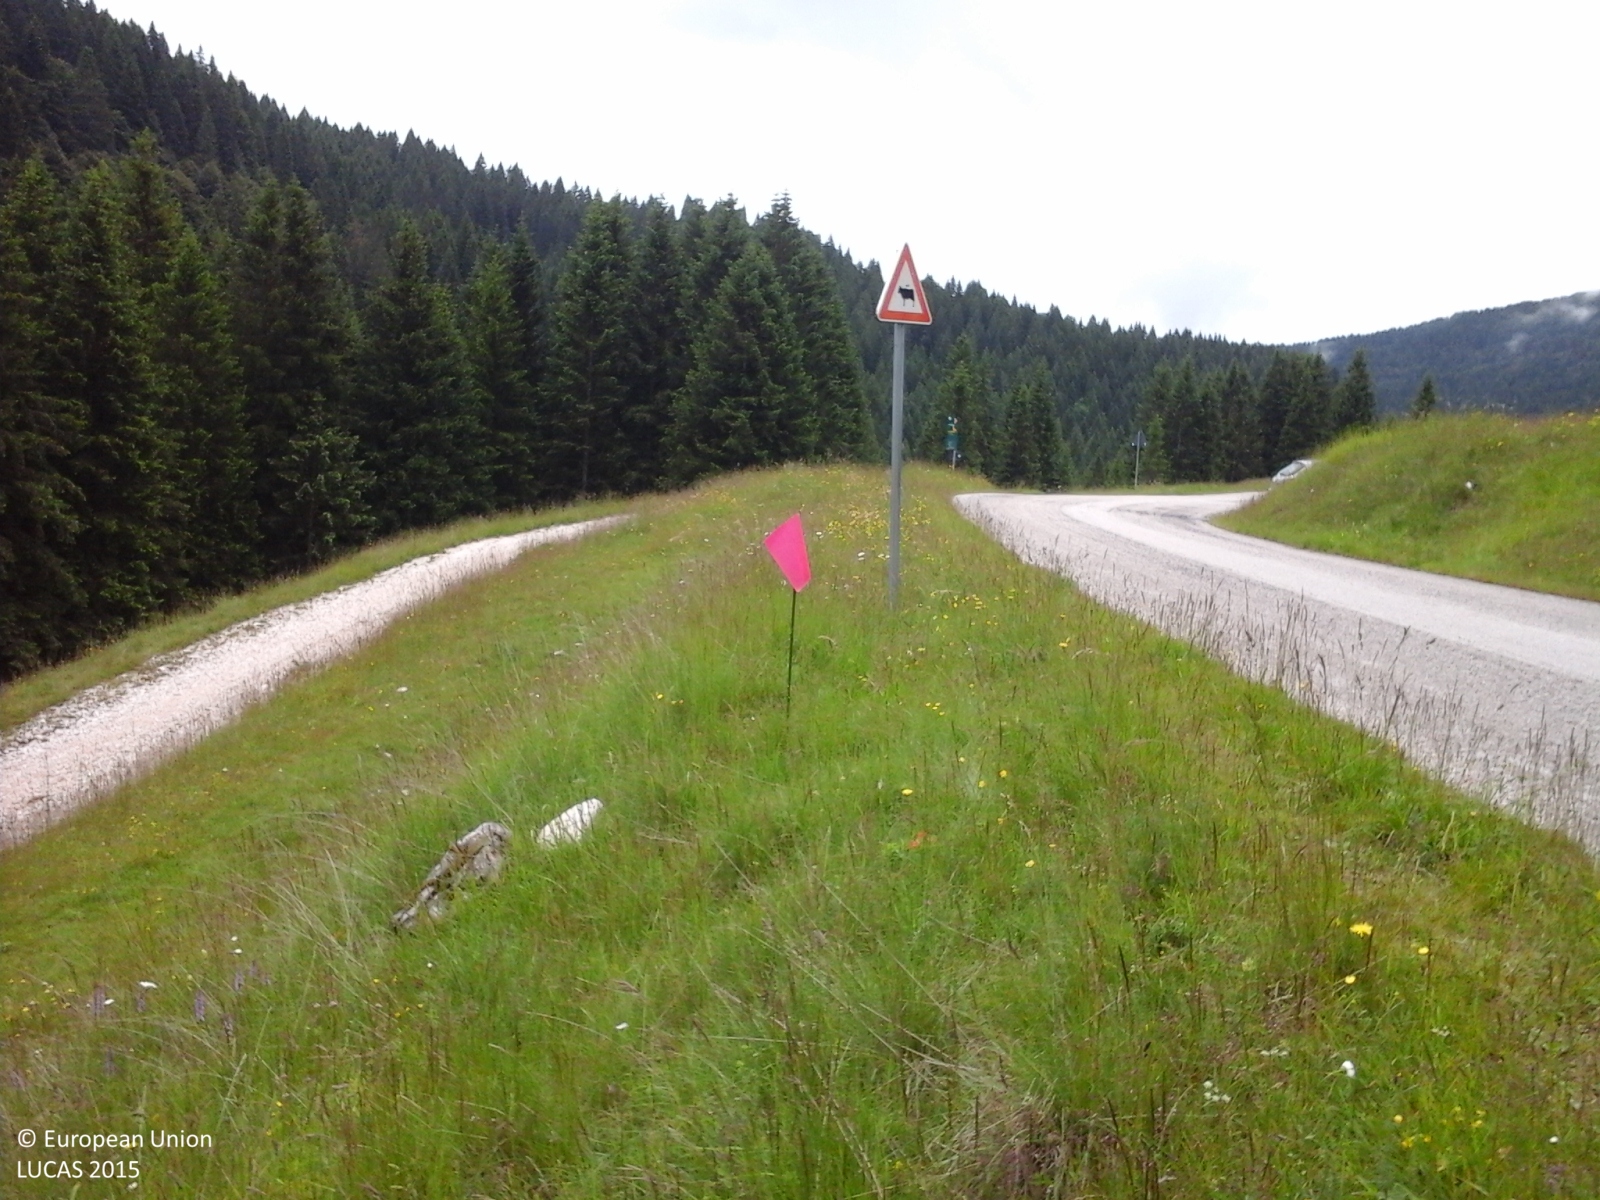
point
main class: Grassland
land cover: Grassland without tree/shrub cover
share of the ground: > 75 %
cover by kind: herbaceous plants 100 %
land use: Agriculture (excluding fallow land and kitchen gardens)
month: June
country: IT
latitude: 45.9423
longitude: 11.6358
